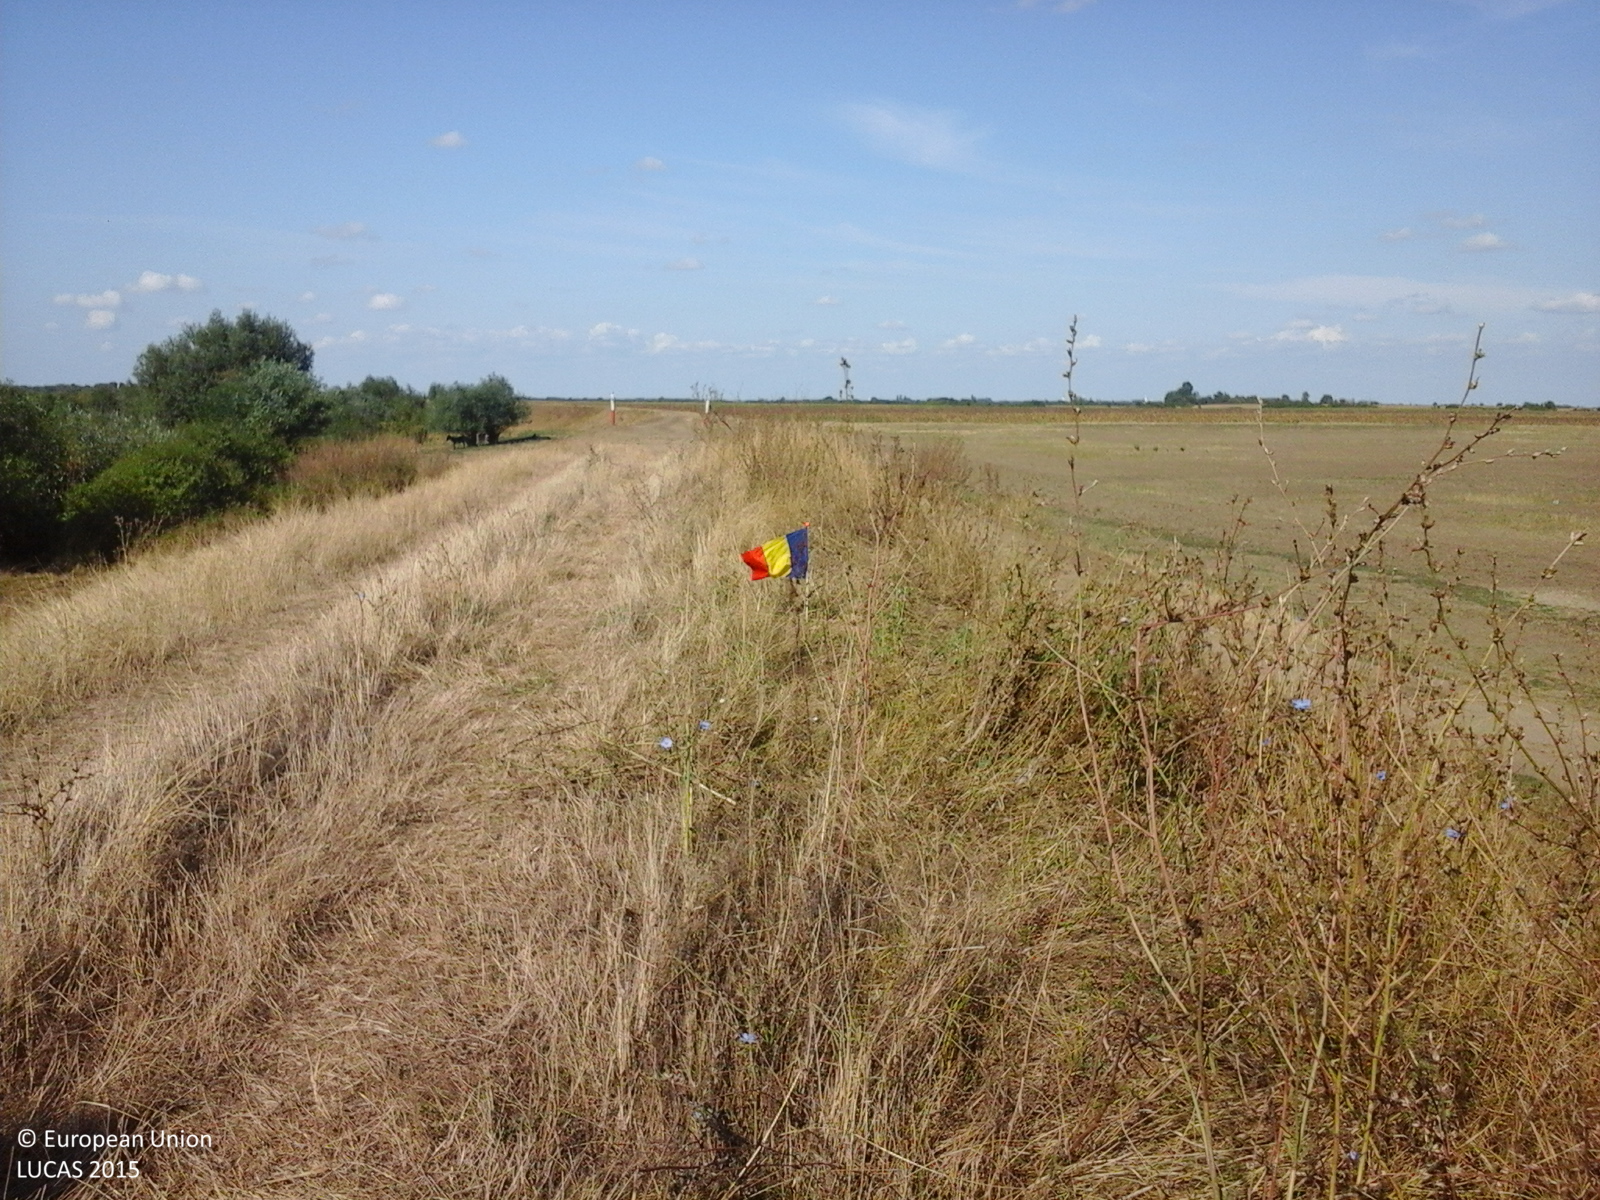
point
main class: Grassland
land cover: Grassland without tree/shrub cover
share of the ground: > 75 %
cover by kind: herbaceous plants 100 %
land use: Agriculture (excluding fallow land and kitchen gardens)
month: September
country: RO
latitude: 47.5876
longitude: 22.7605
